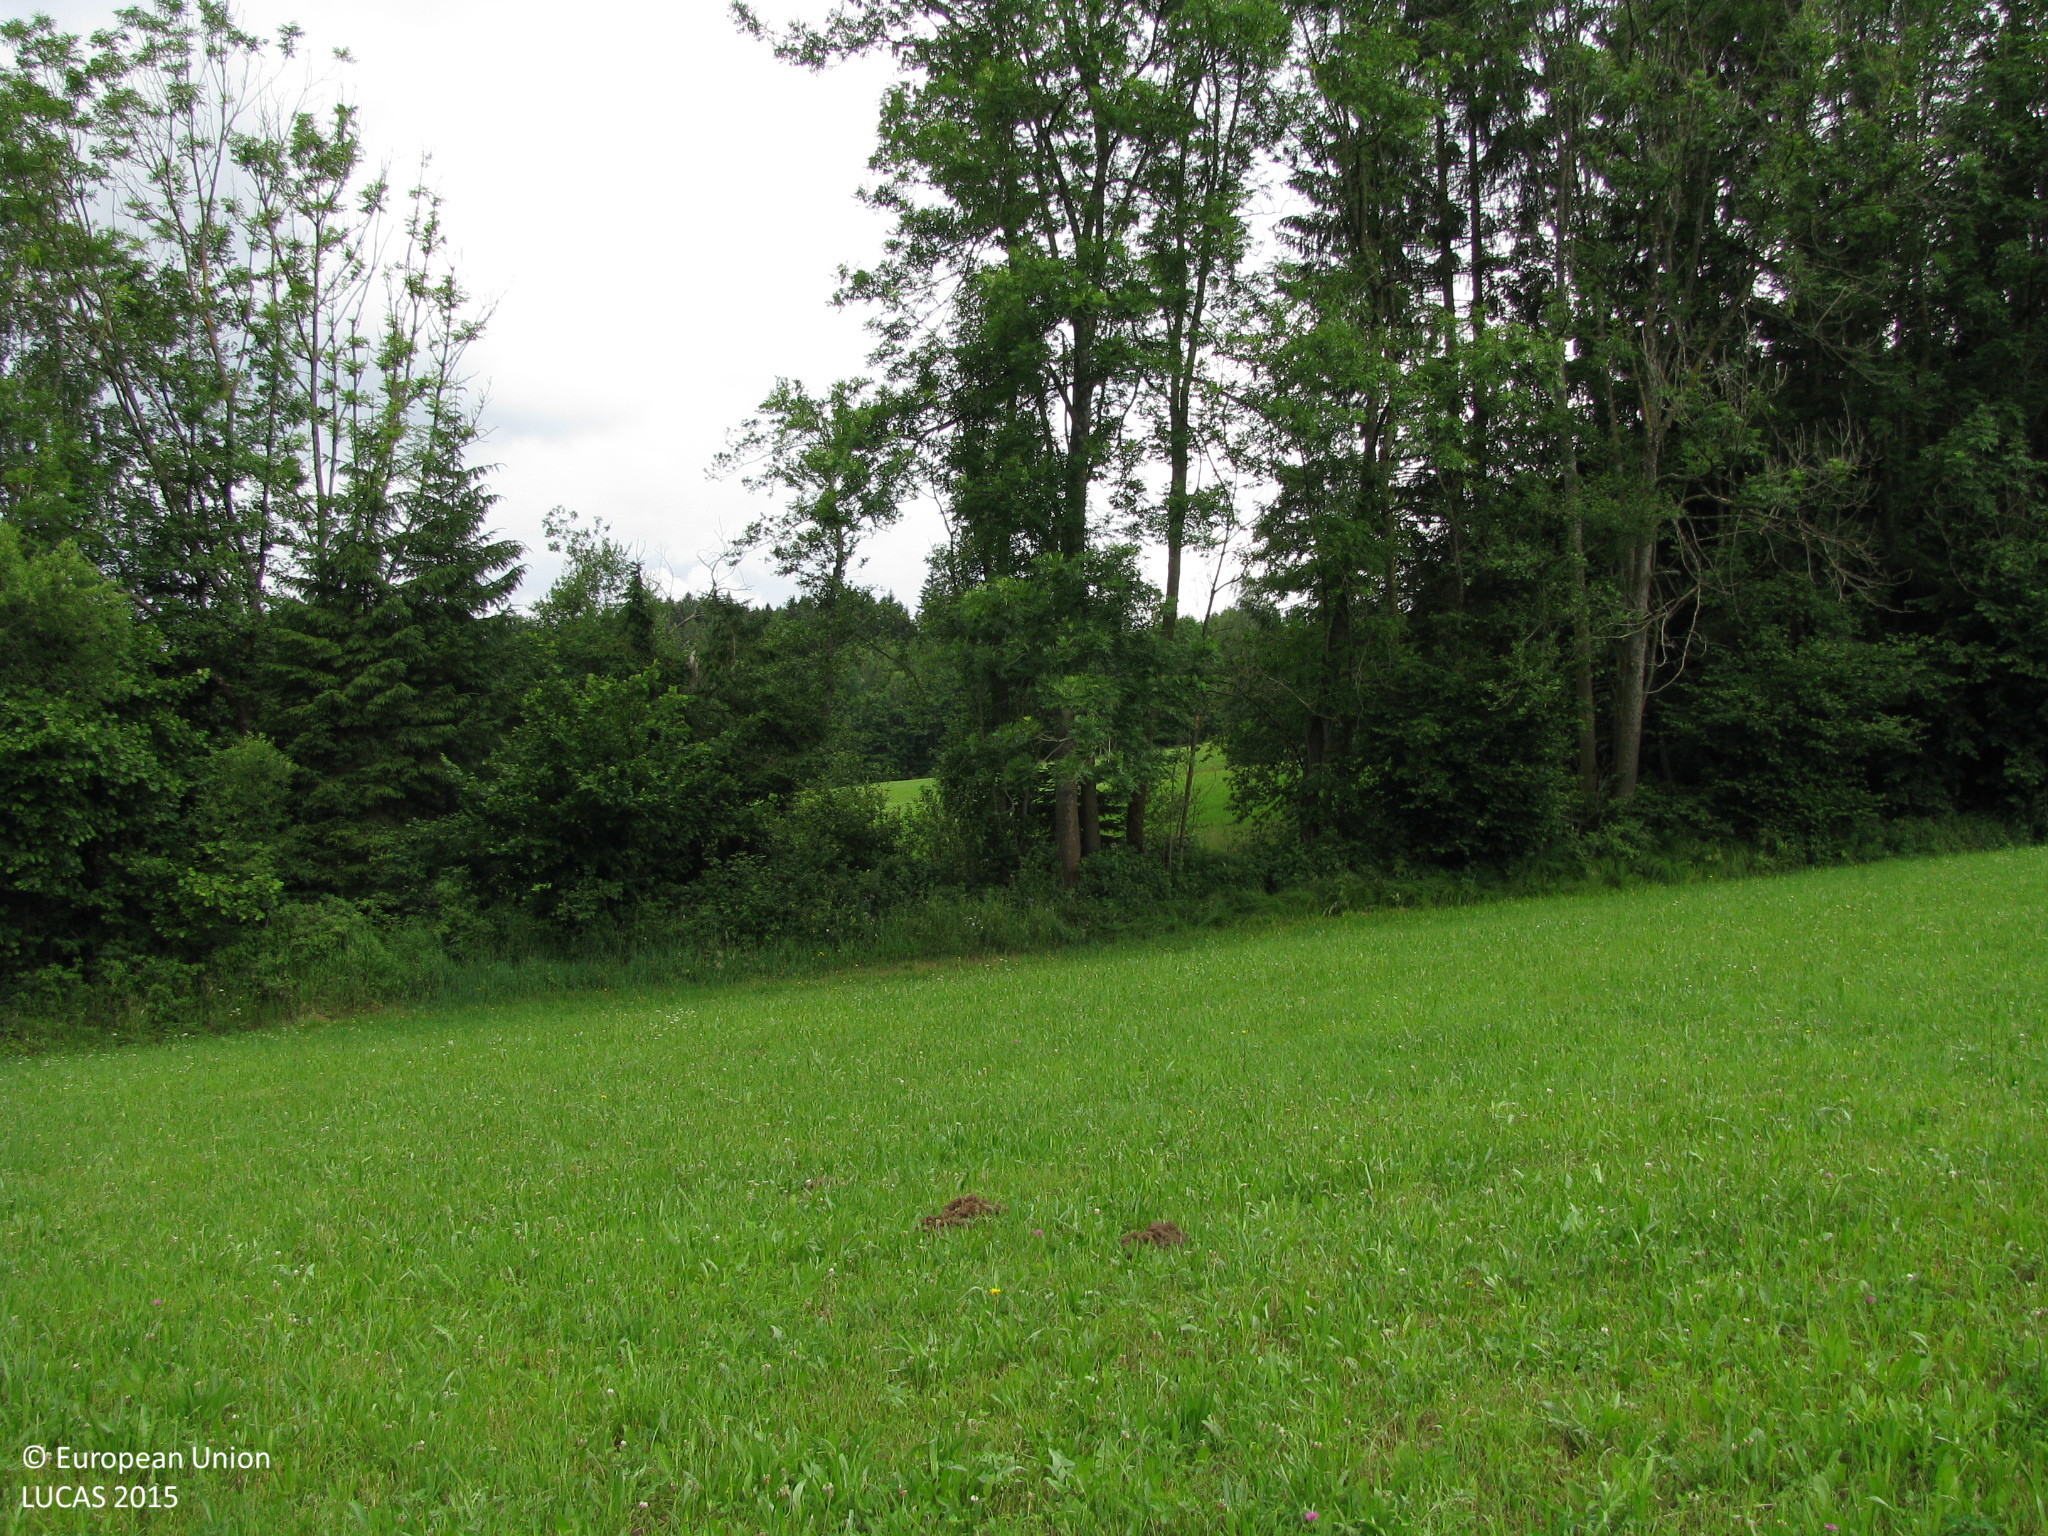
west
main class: Grassland
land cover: Grassland without tree/shrub cover
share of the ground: > 75 %
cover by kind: herbaceous plants 100 %
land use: Agriculture (excluding fallow land and kitchen gardens)
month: June
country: AT
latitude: 47.2741
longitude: 14.7446
